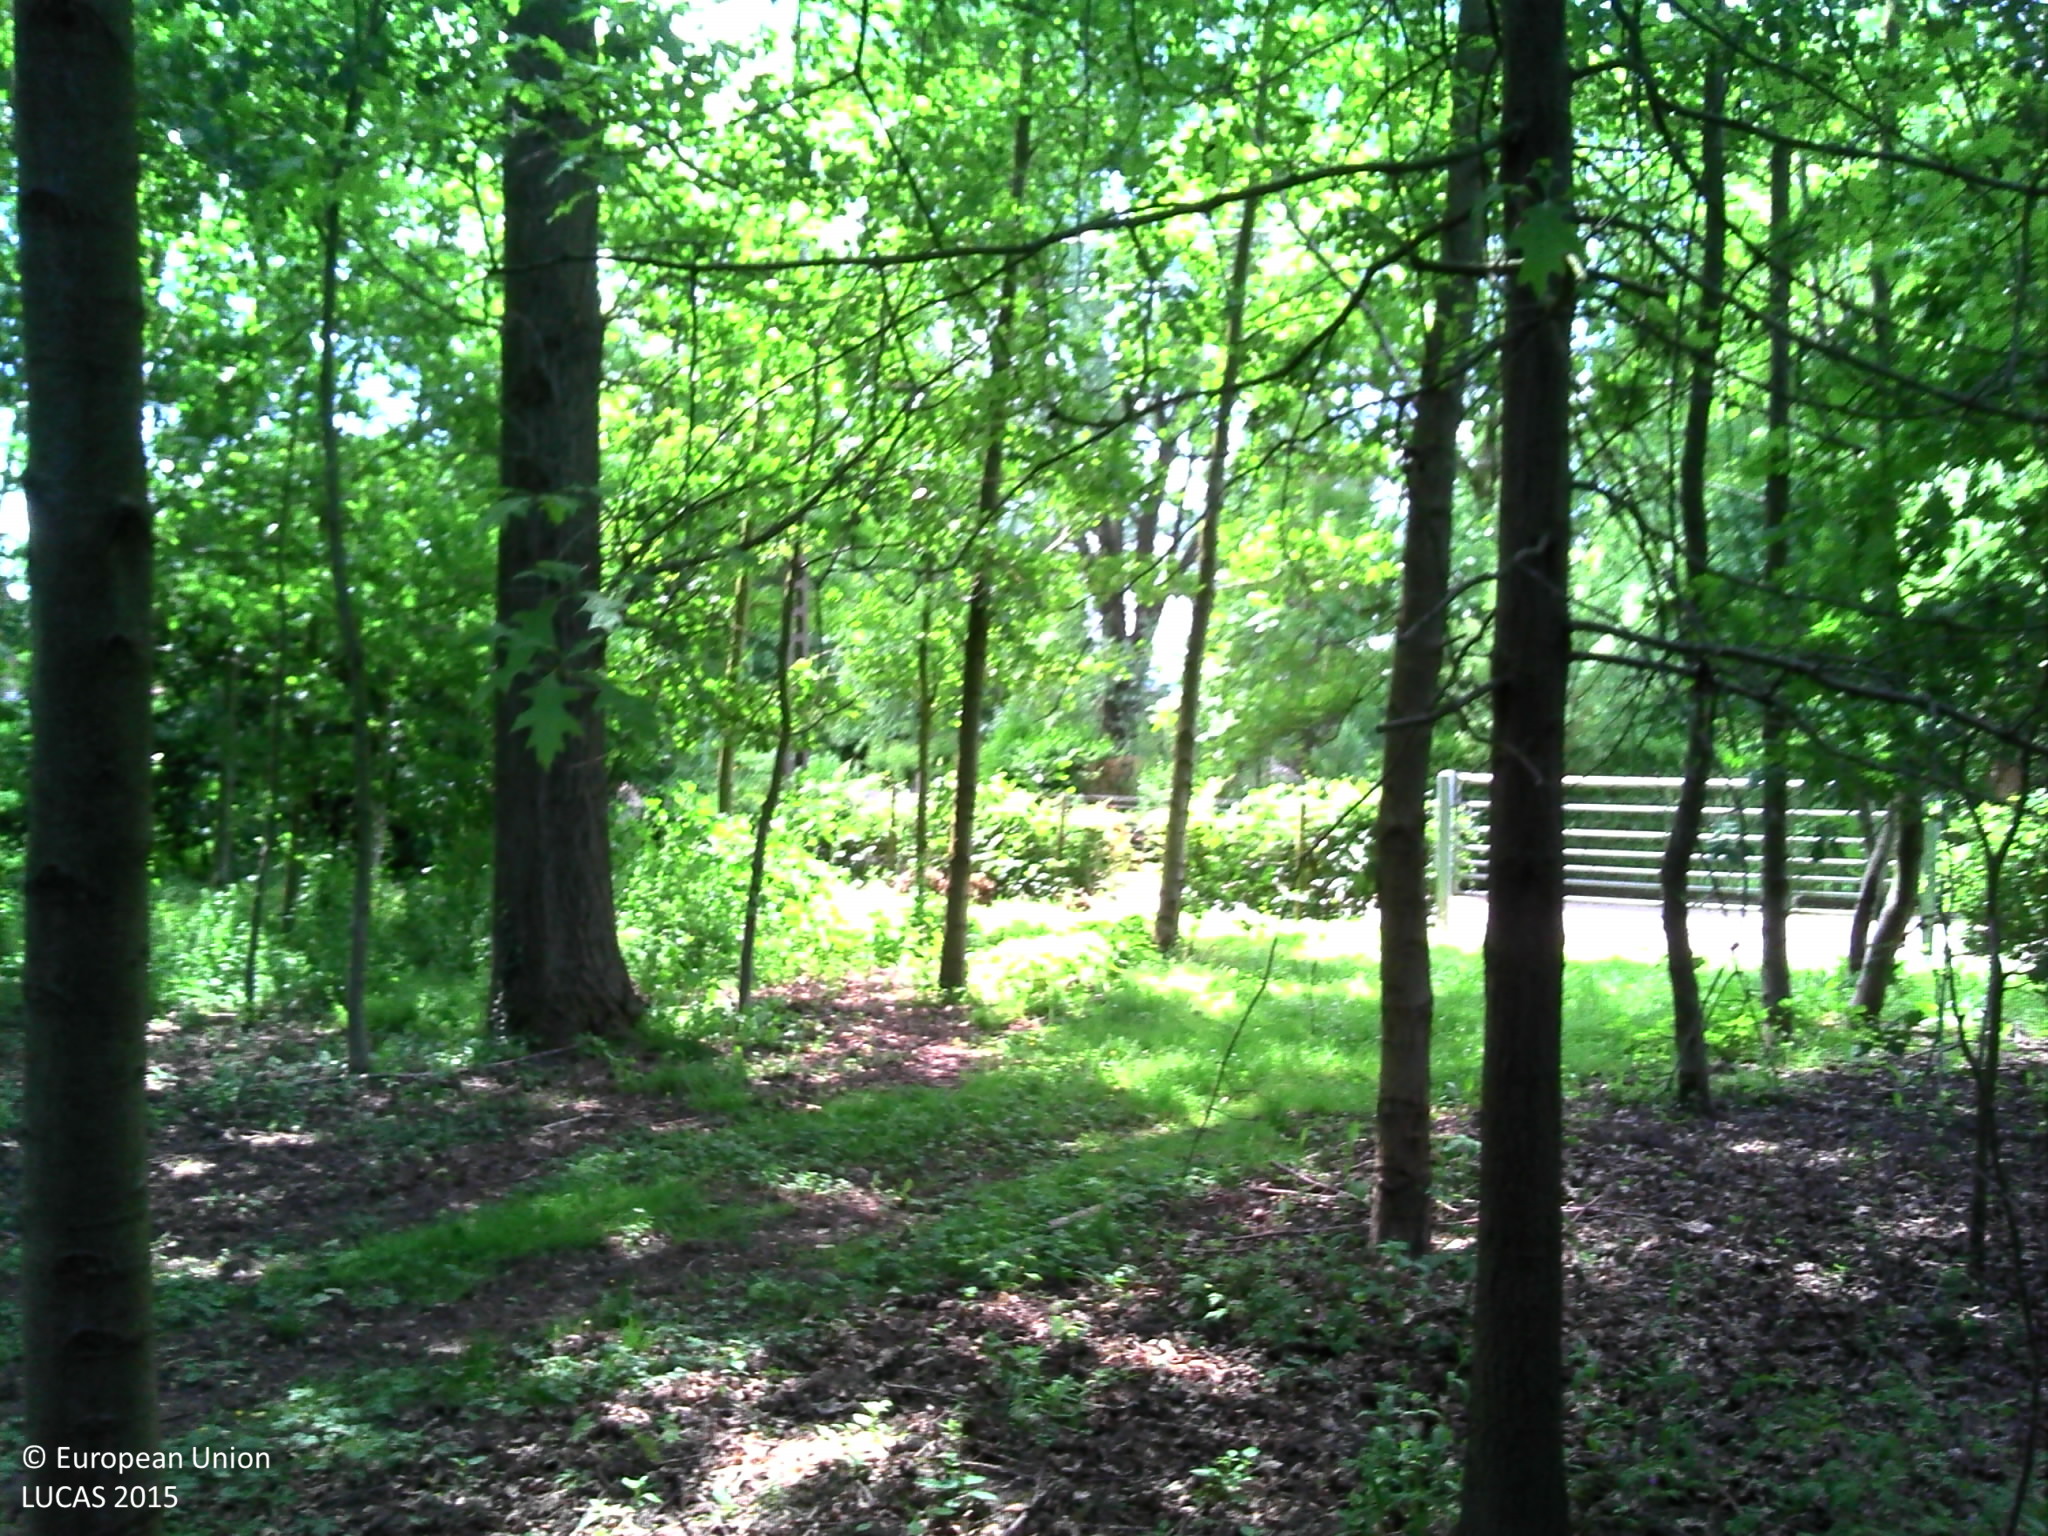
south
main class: Woodland
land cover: Broadleaved woodland
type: mesophytic deciduous forest
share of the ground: > 75 %
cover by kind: broadleaved forest trees 100 %
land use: Residential
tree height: > 5 m
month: June
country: BE
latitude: 50.8935
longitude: 3.6948
